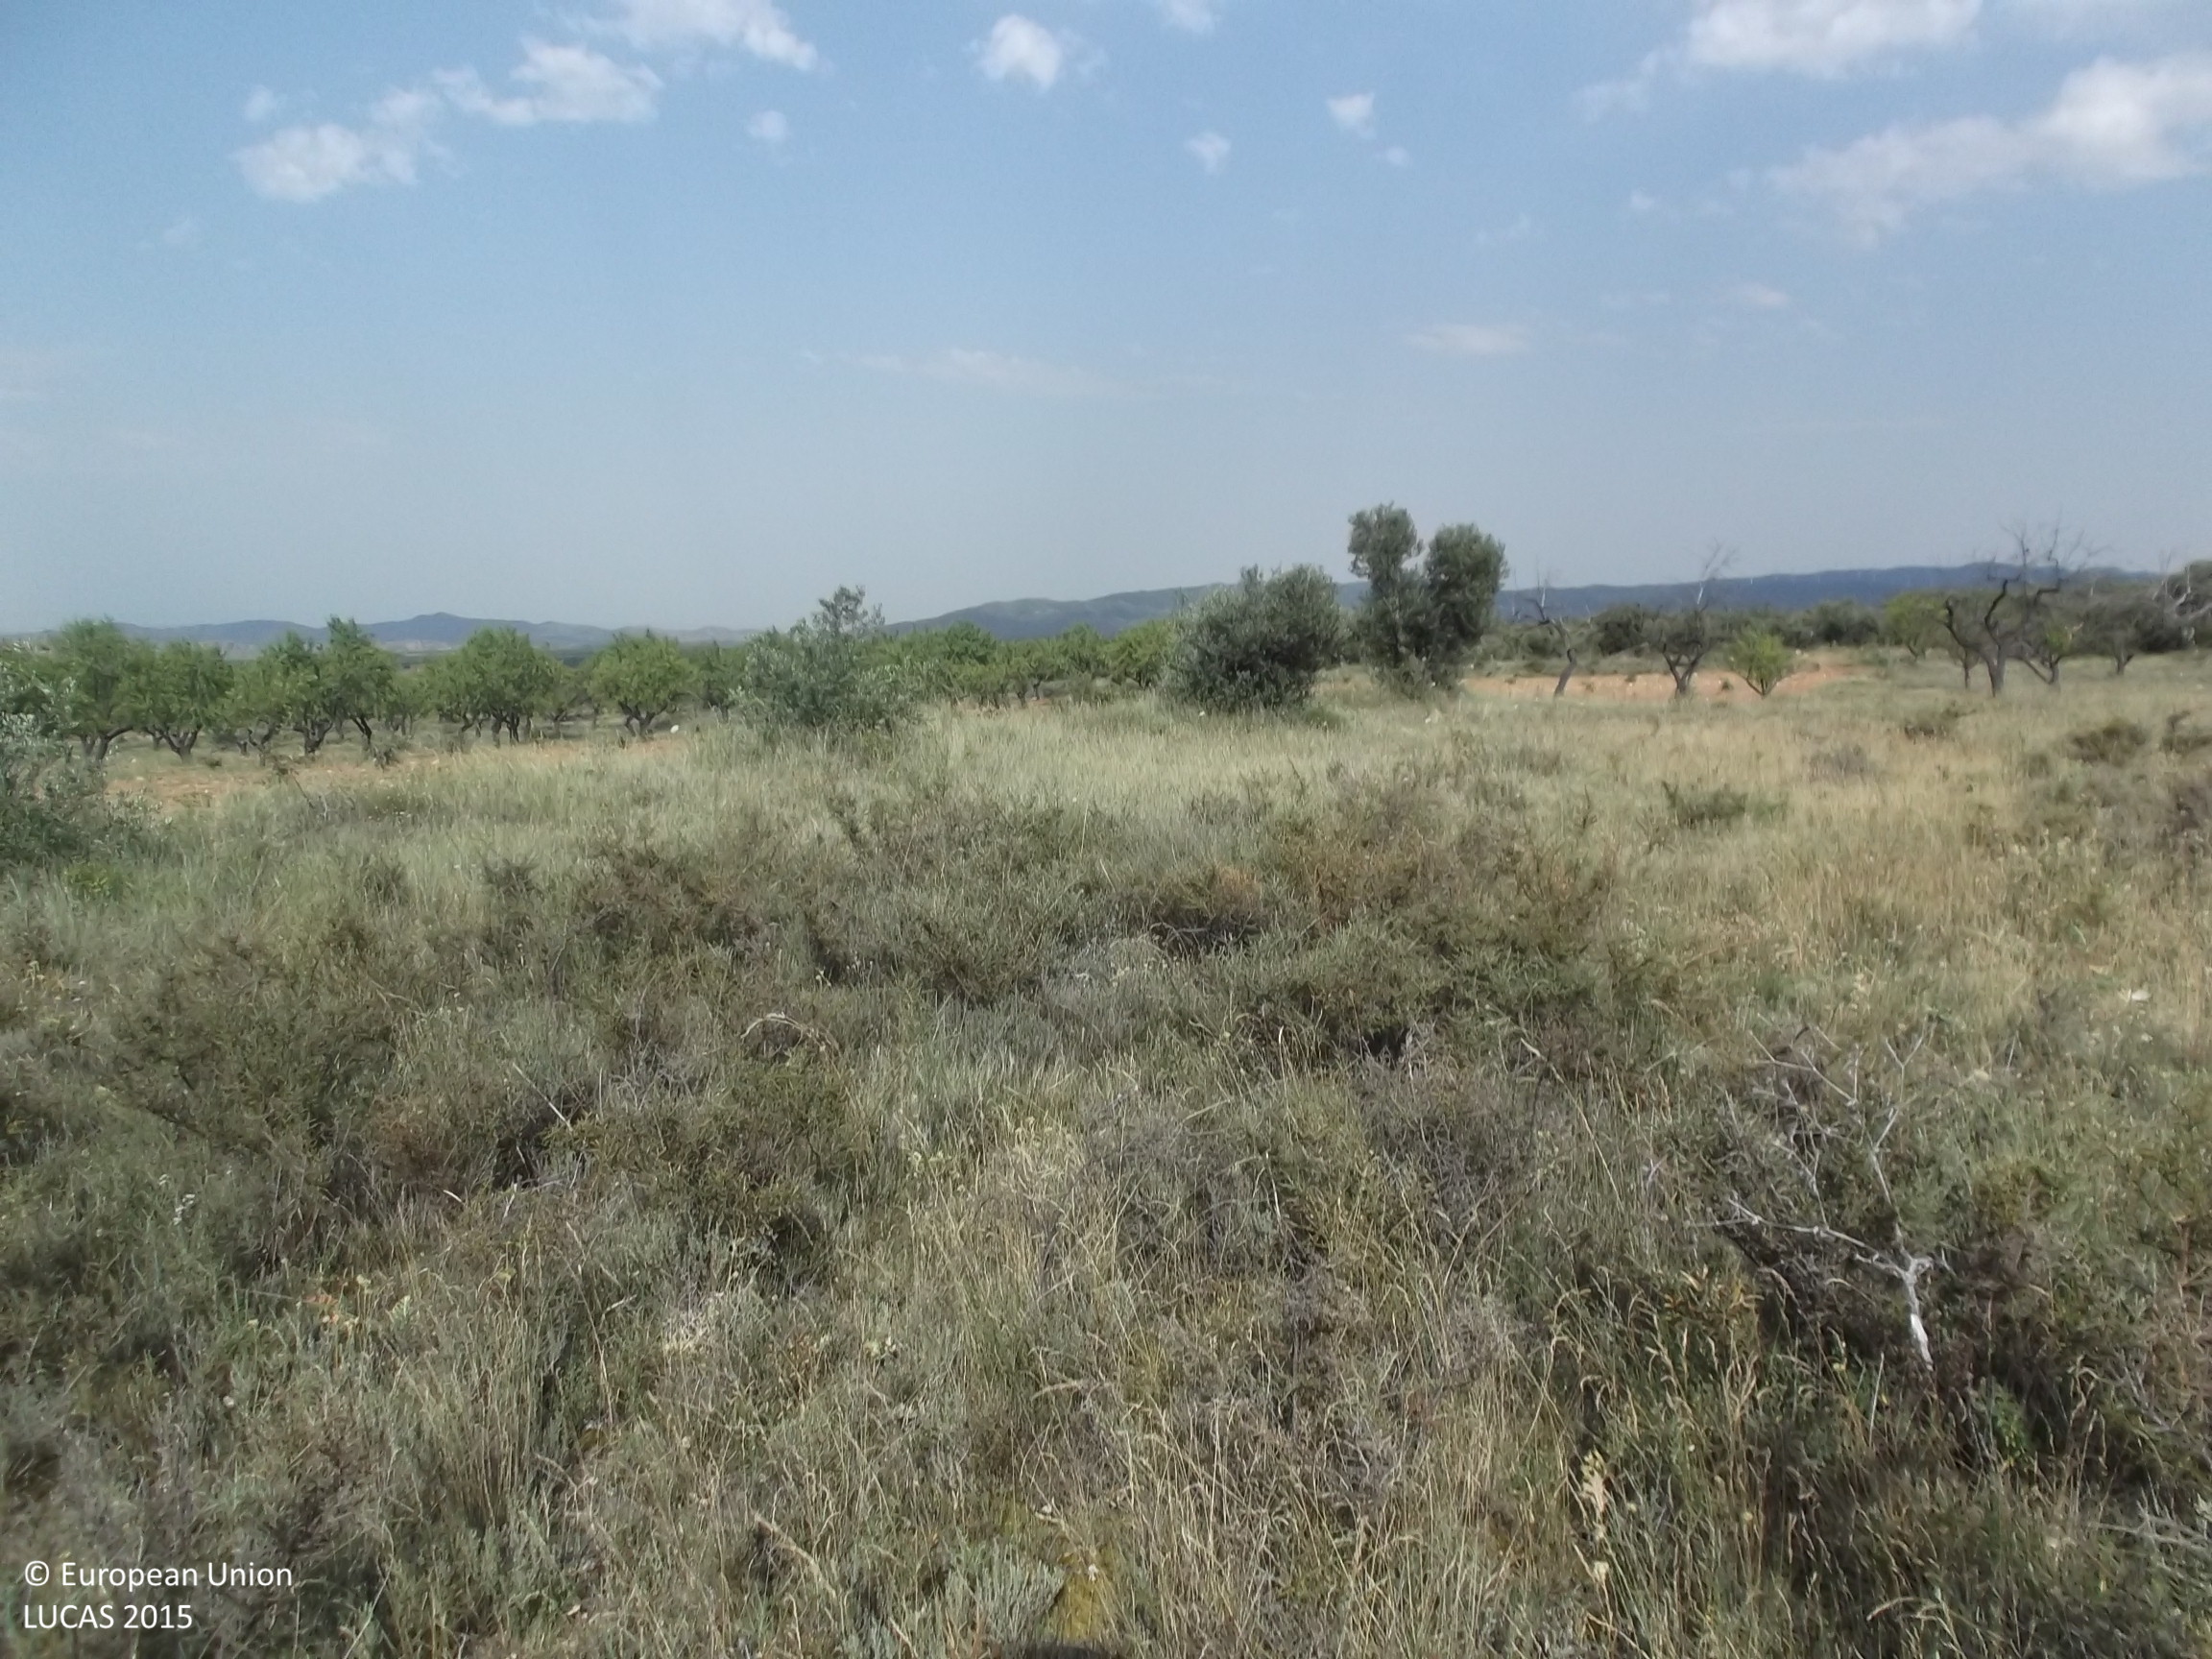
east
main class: Shrubland
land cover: Shrubland without tree cover
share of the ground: > 75 %
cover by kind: shrubs 80 %, herbaceous plants 20 %
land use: Semi-natural and natural areas not in use
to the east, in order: Shrubland without tree cover; Olive groves; Nuts trees; Broadleaved woodland; Olive groves; Tracks; Single bushes/trees; Rivers and streams; Tracks; Nuts trees; Dry stone walls; Fences; Spontaneously vegetated surfaces; Vineyards
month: July
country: ES
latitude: 42.1979
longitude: -2.1124
